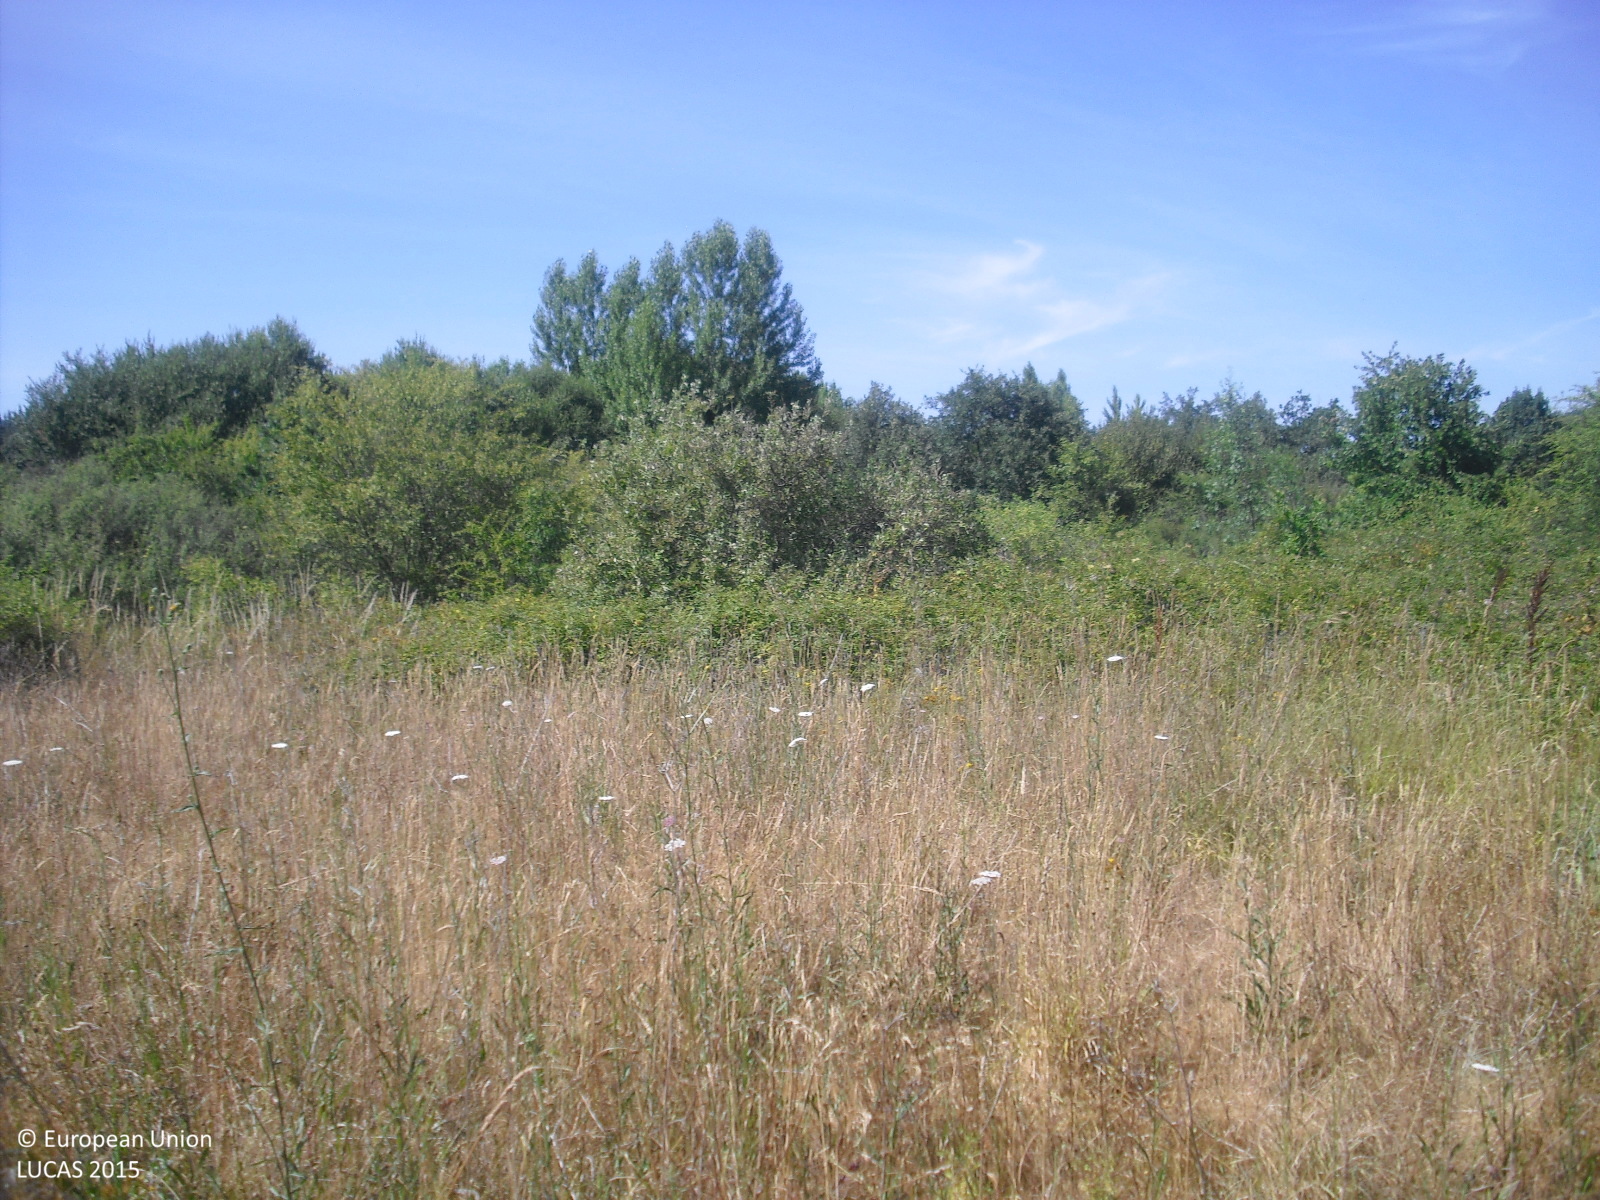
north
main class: Shrubland
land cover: Shrubland with sparse tree cover
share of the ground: 50 - 75 %
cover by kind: shrubs 60 %, herbaceous plants 35 %, broadleaved forest trees 5 %
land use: Abandoned areas
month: July
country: ES
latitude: 42.5547
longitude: -7.4981
